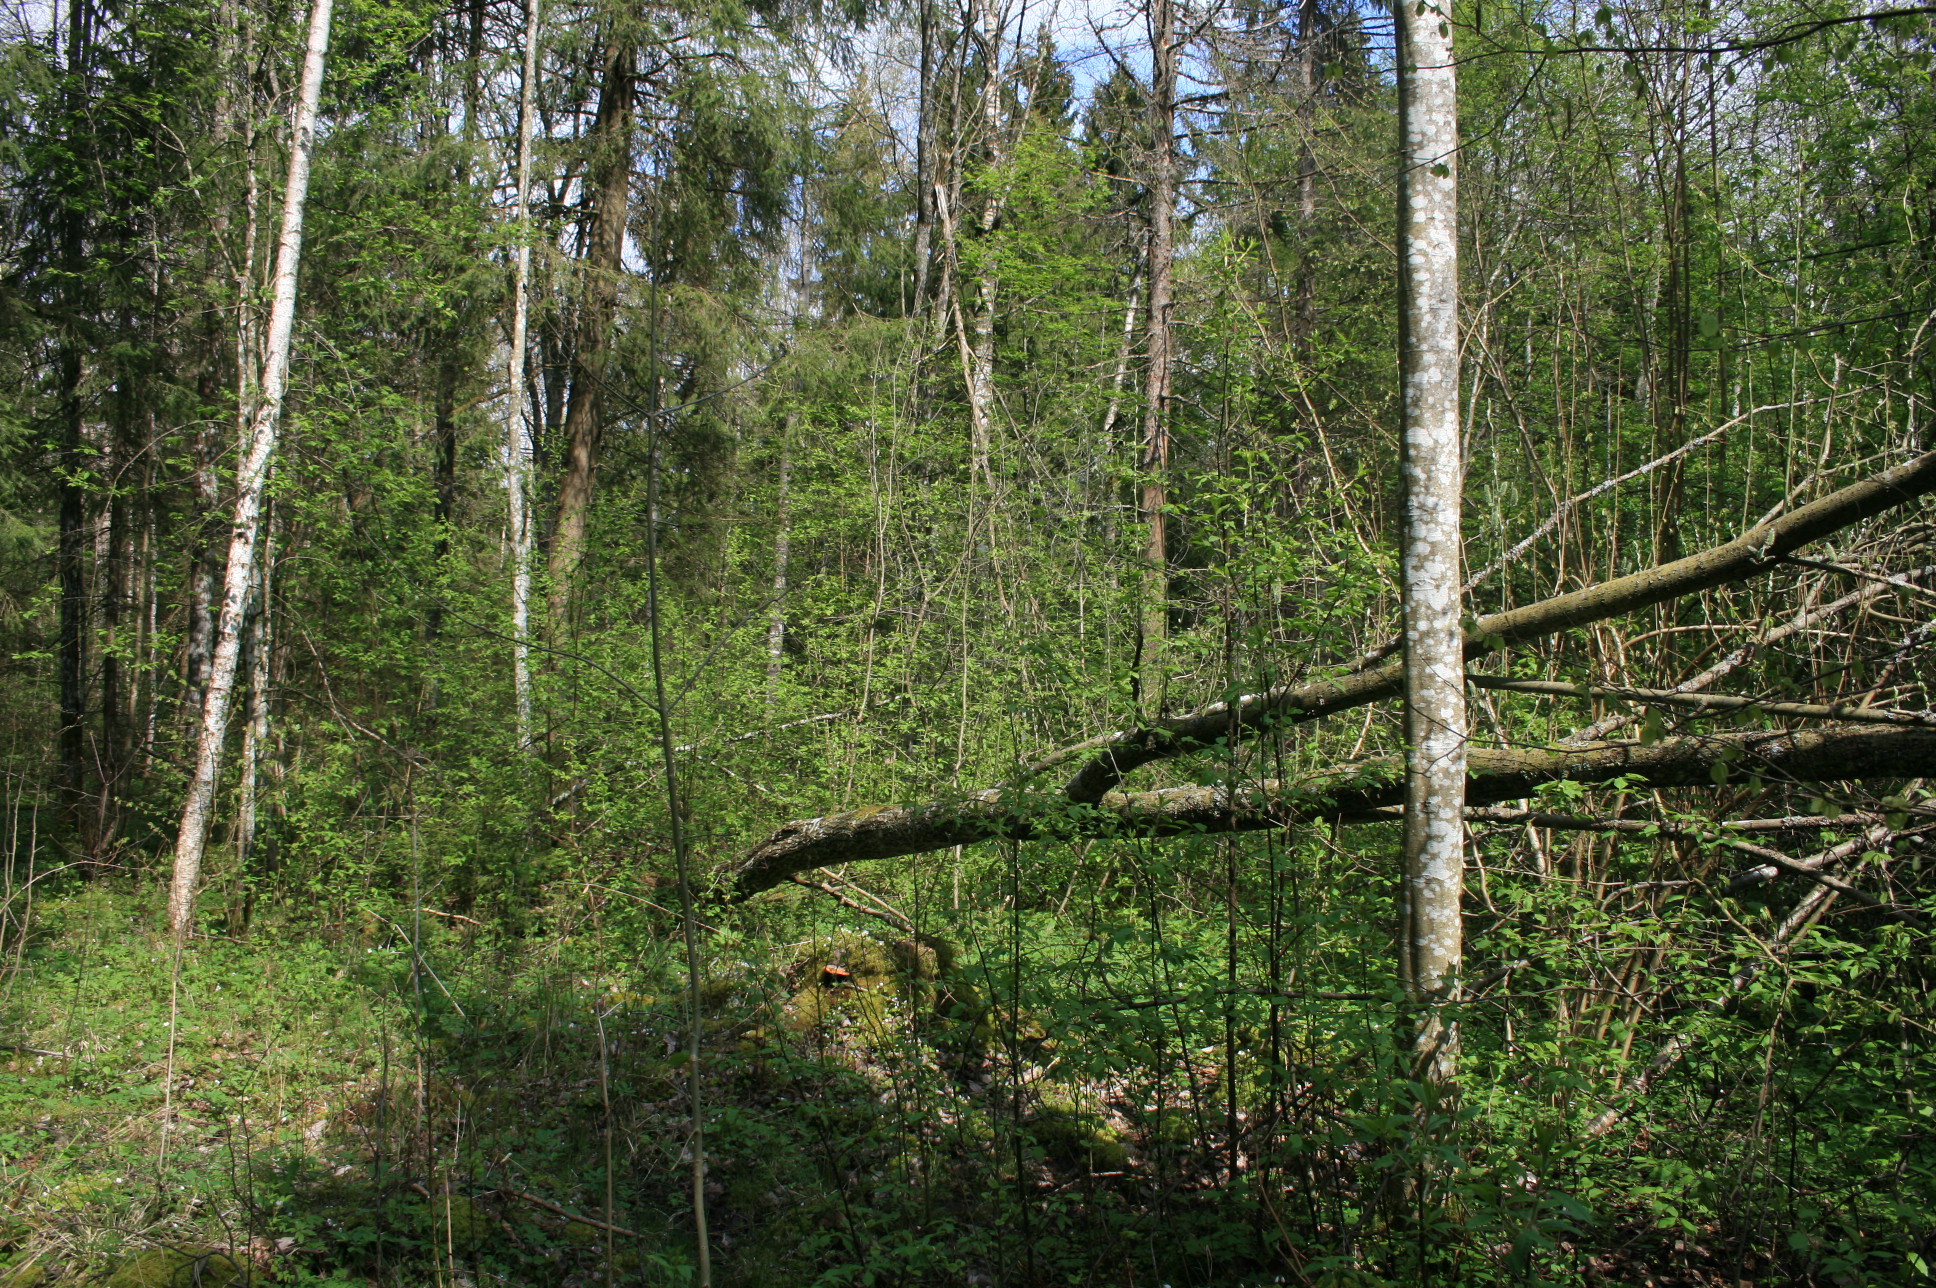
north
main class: Woodland
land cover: Spruce dominated mixed woodland
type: hemiboreal forest and nemoral coniferous forest and mixed broadleaved-coniferous forest
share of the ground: > 75 %
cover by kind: broadleaved forest trees 60 %, coniferous forest trees 40 %
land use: Forestry
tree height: > 5 m
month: May
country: LT
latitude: 56.3258
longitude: 22.0663
